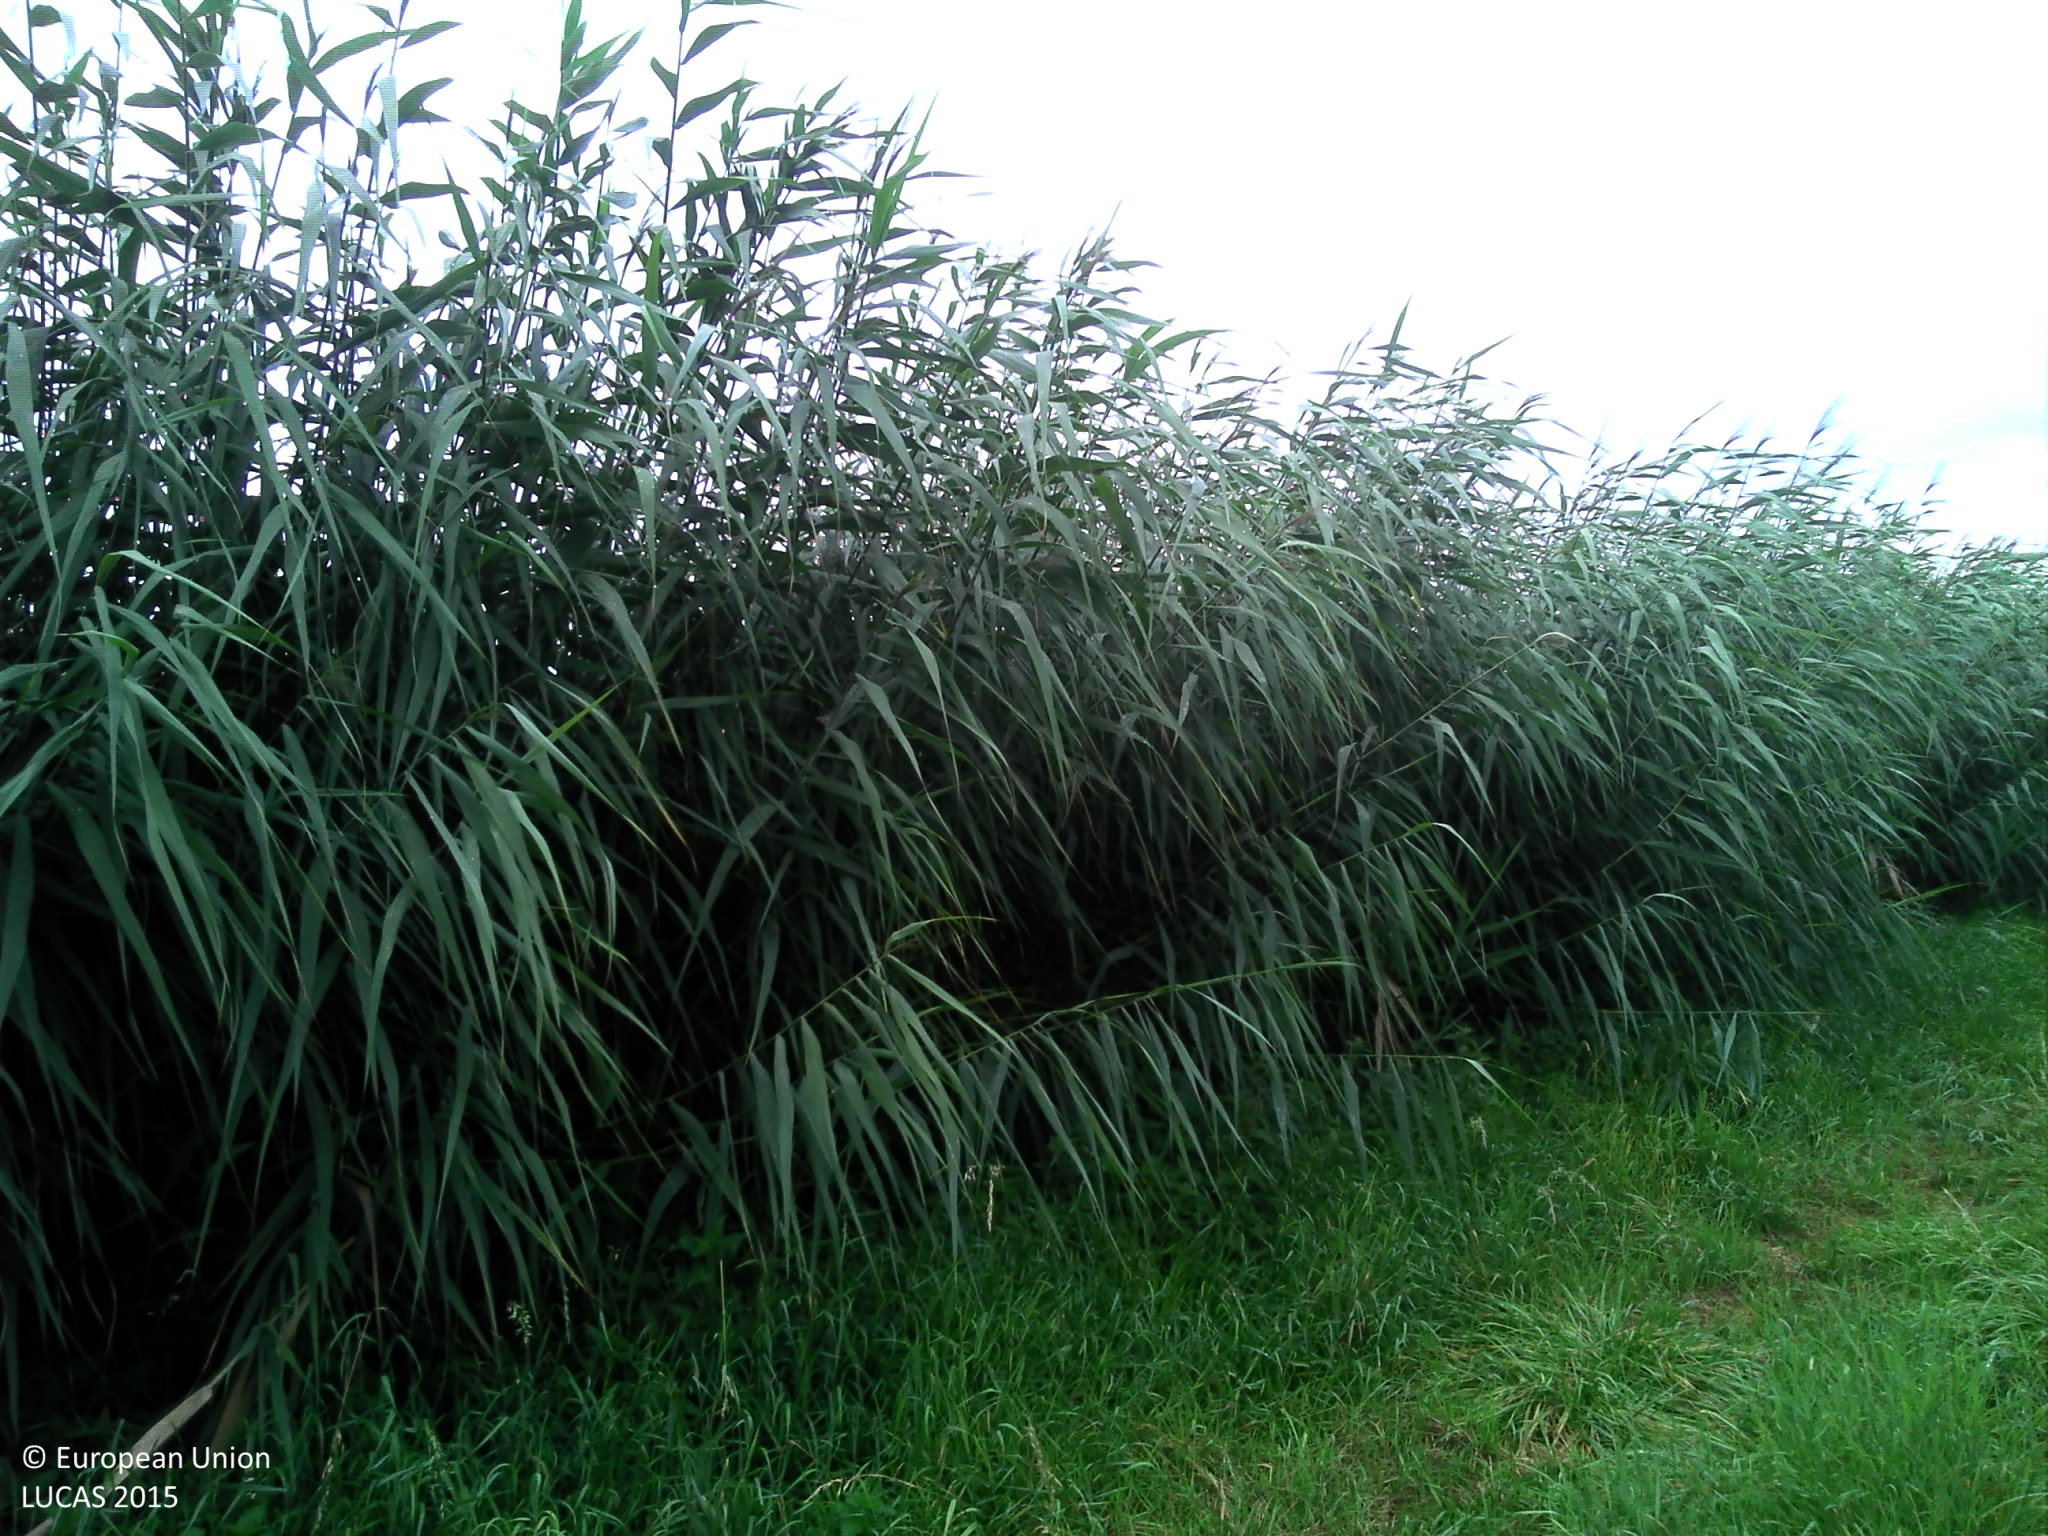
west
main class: Cropland
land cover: Maize
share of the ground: > 75 %
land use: Agriculture (excluding fallow land and kitchen gardens)
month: August
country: FR
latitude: 48.9262
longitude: 8.0489
